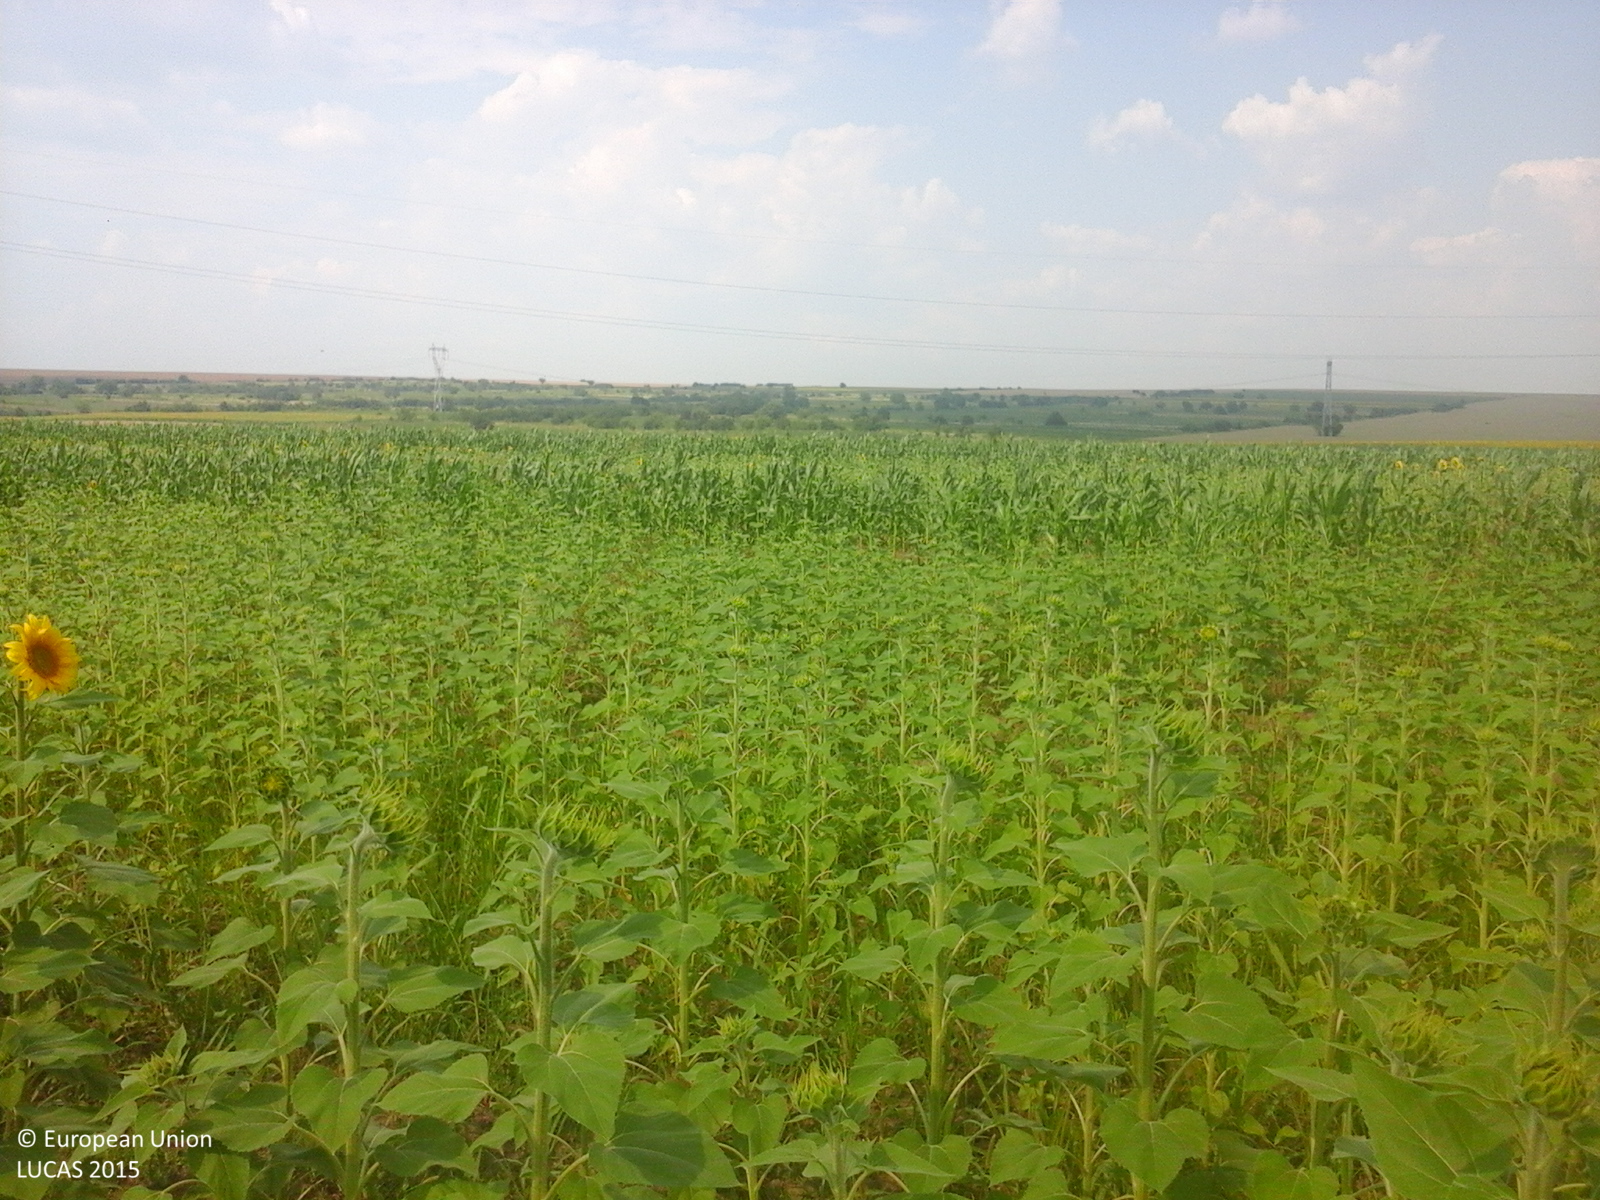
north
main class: Cropland
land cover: Sunflower
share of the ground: > 75 %
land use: Agriculture (excluding fallow land and kitchen gardens)
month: July
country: RO
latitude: 43.8308
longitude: 24.8069
